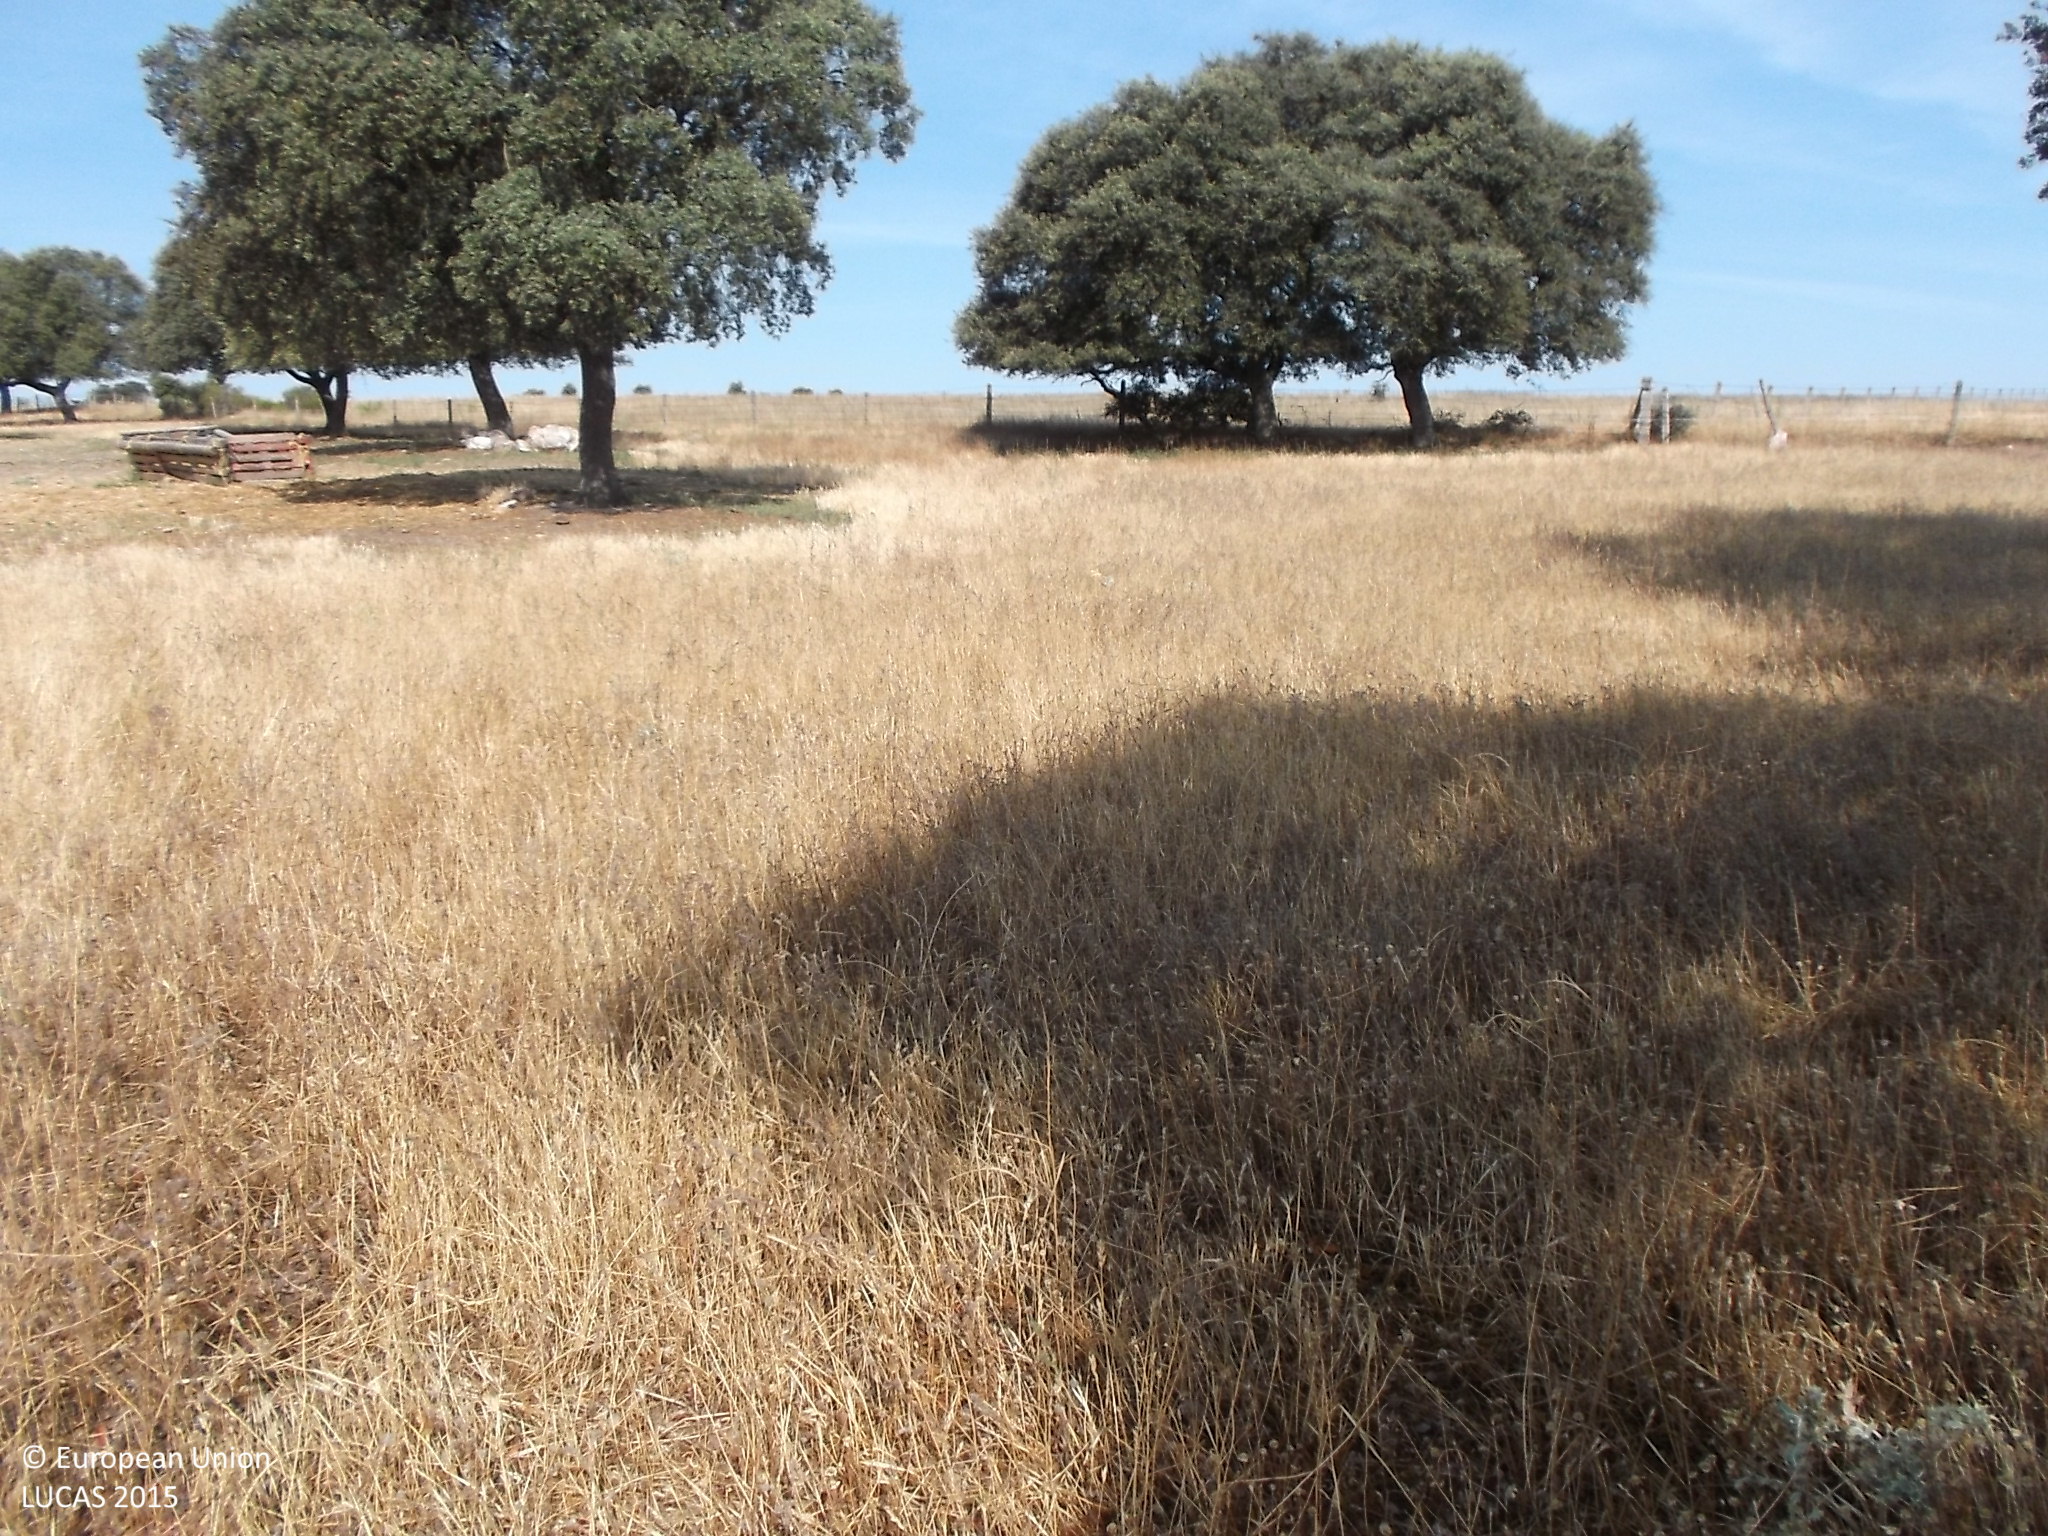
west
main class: Woodland
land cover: Broadleaved woodland
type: broadleaved evergreen forest
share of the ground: 25 - 50 %
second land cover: Grassland without tree/shrub cover
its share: 50 - 75 %
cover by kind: herbaceous plants 70 %, broadleaved forest trees 30 %
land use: Forestry
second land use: Agriculture (excluding fallow land and kitchen gardens)
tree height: < 5 m
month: June
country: ES
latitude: 41.1742
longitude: -5.9758
